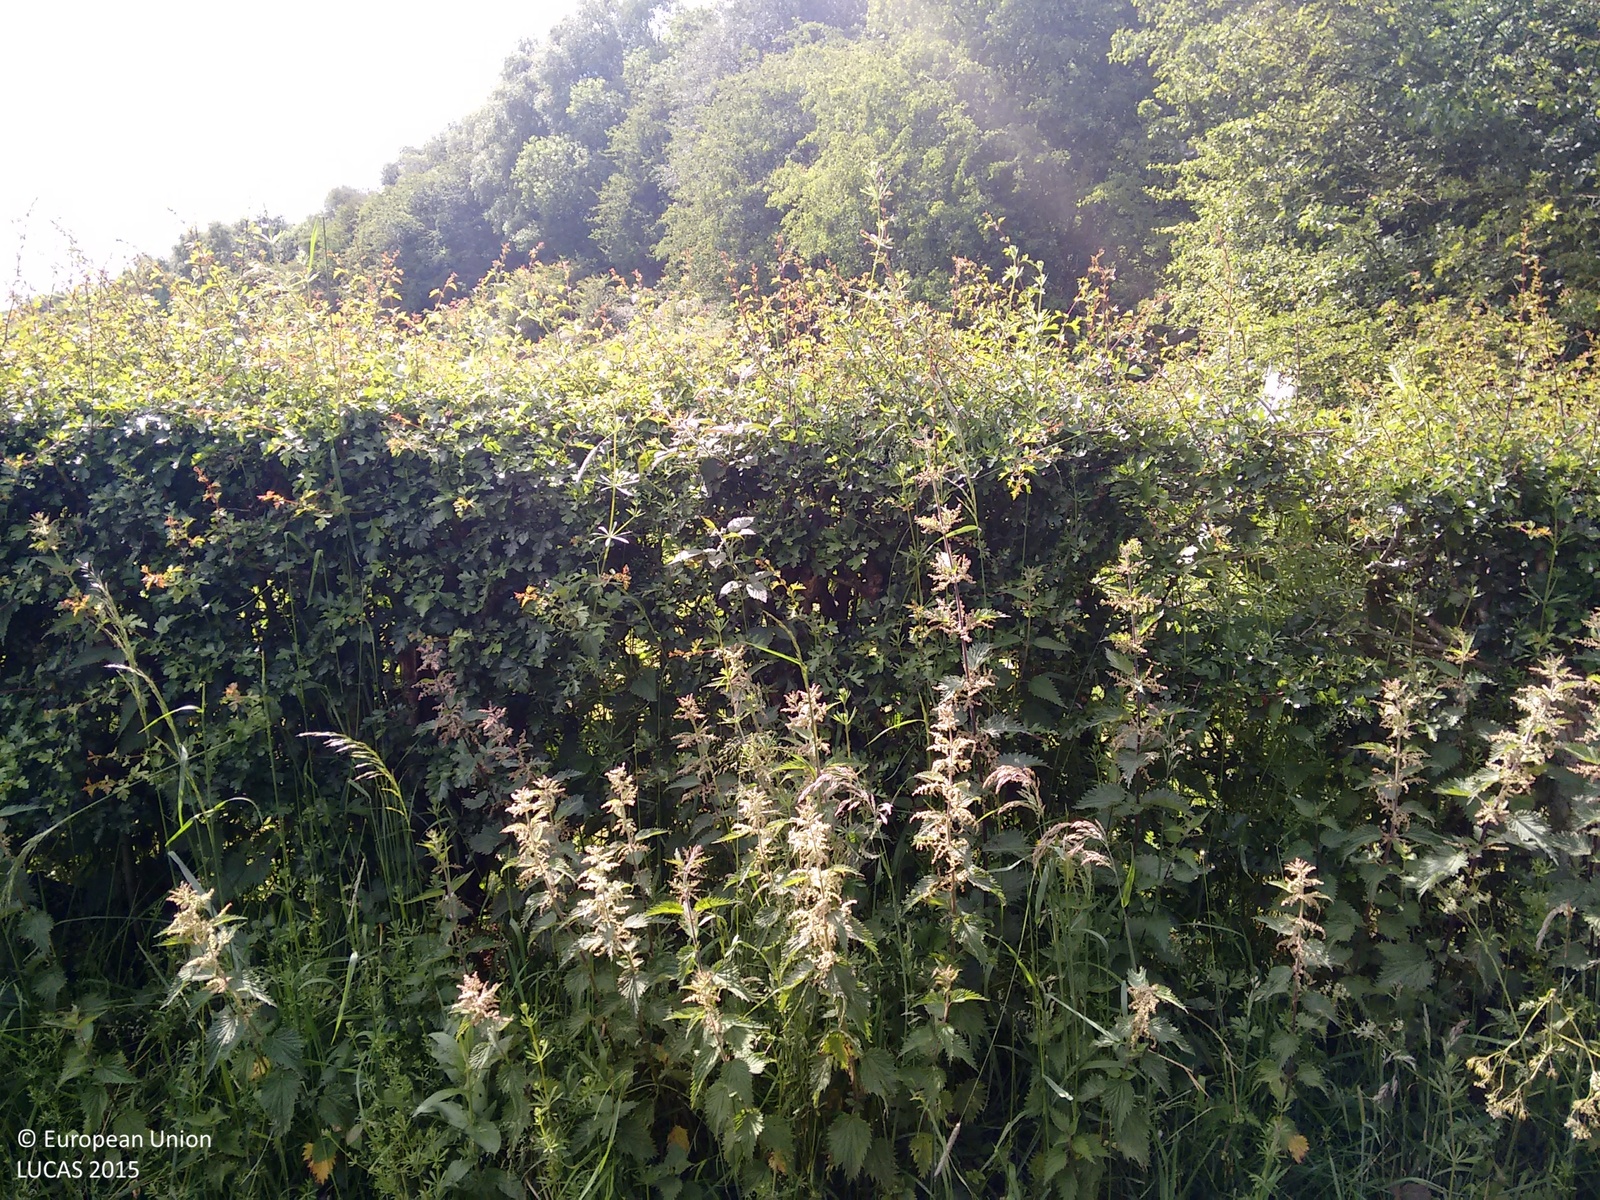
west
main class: Grassland
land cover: Grassland without tree/shrub cover
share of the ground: > 75 %
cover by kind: herbaceous plants 100 %
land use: Agriculture (excluding fallow land and kitchen gardens)
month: June
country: GB
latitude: 53.5533
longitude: -2.4879
